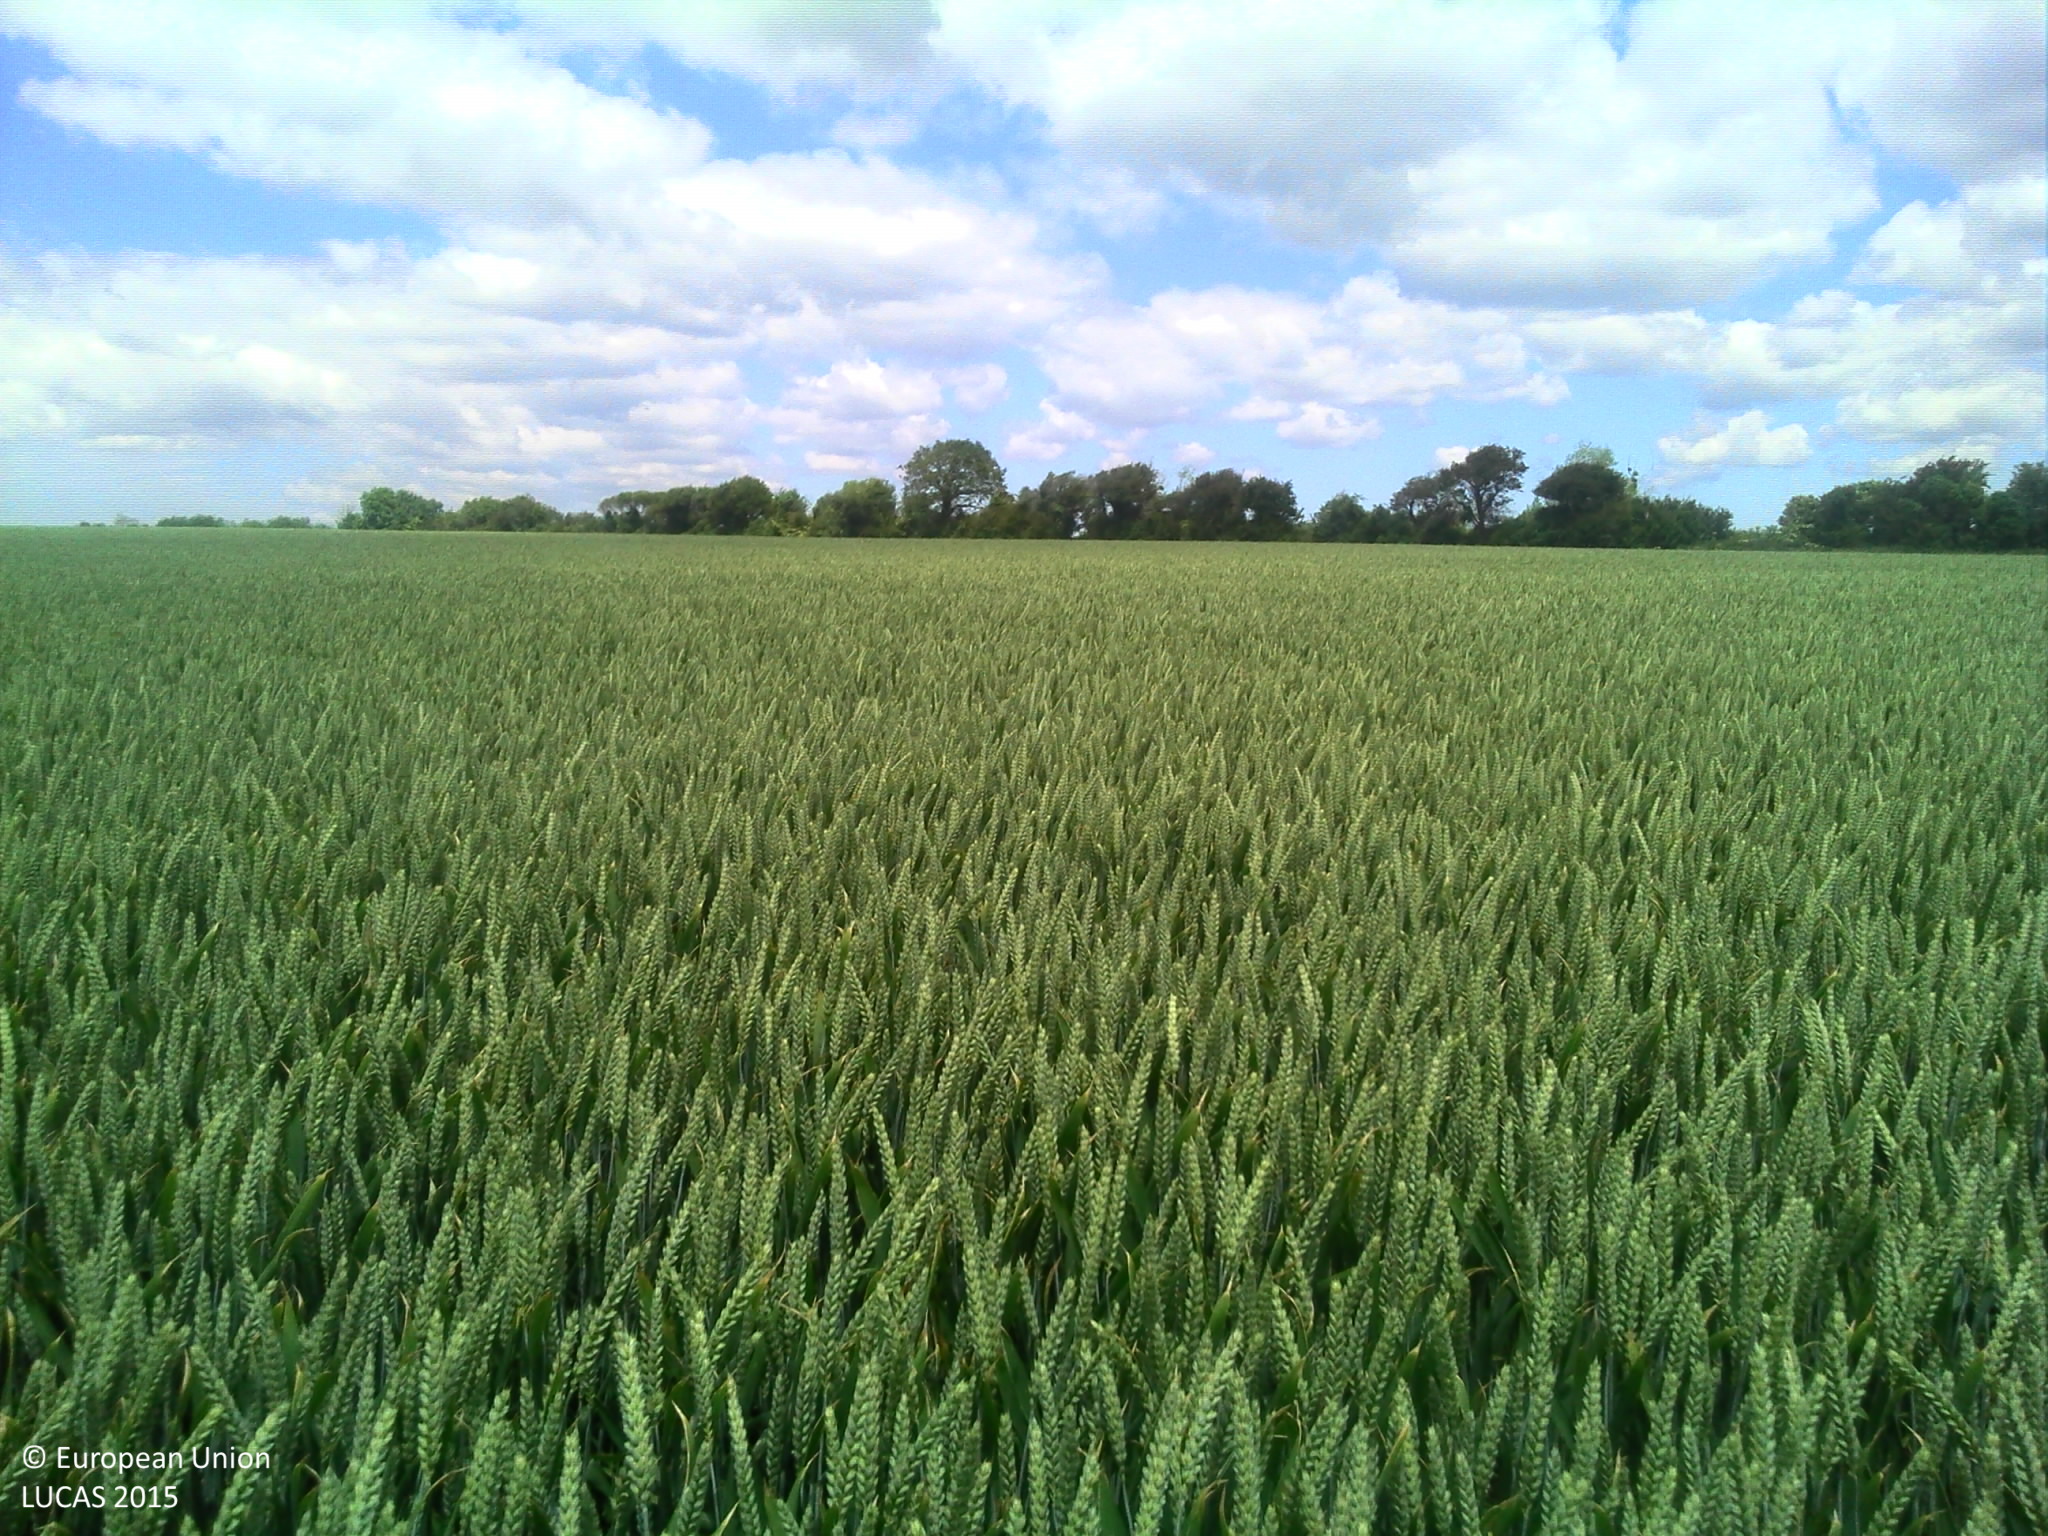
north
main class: Cropland
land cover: Common wheat
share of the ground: > 75 %
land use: Agriculture (excluding fallow land and kitchen gardens)
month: June
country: FR
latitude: 49.3450
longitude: -1.6826
